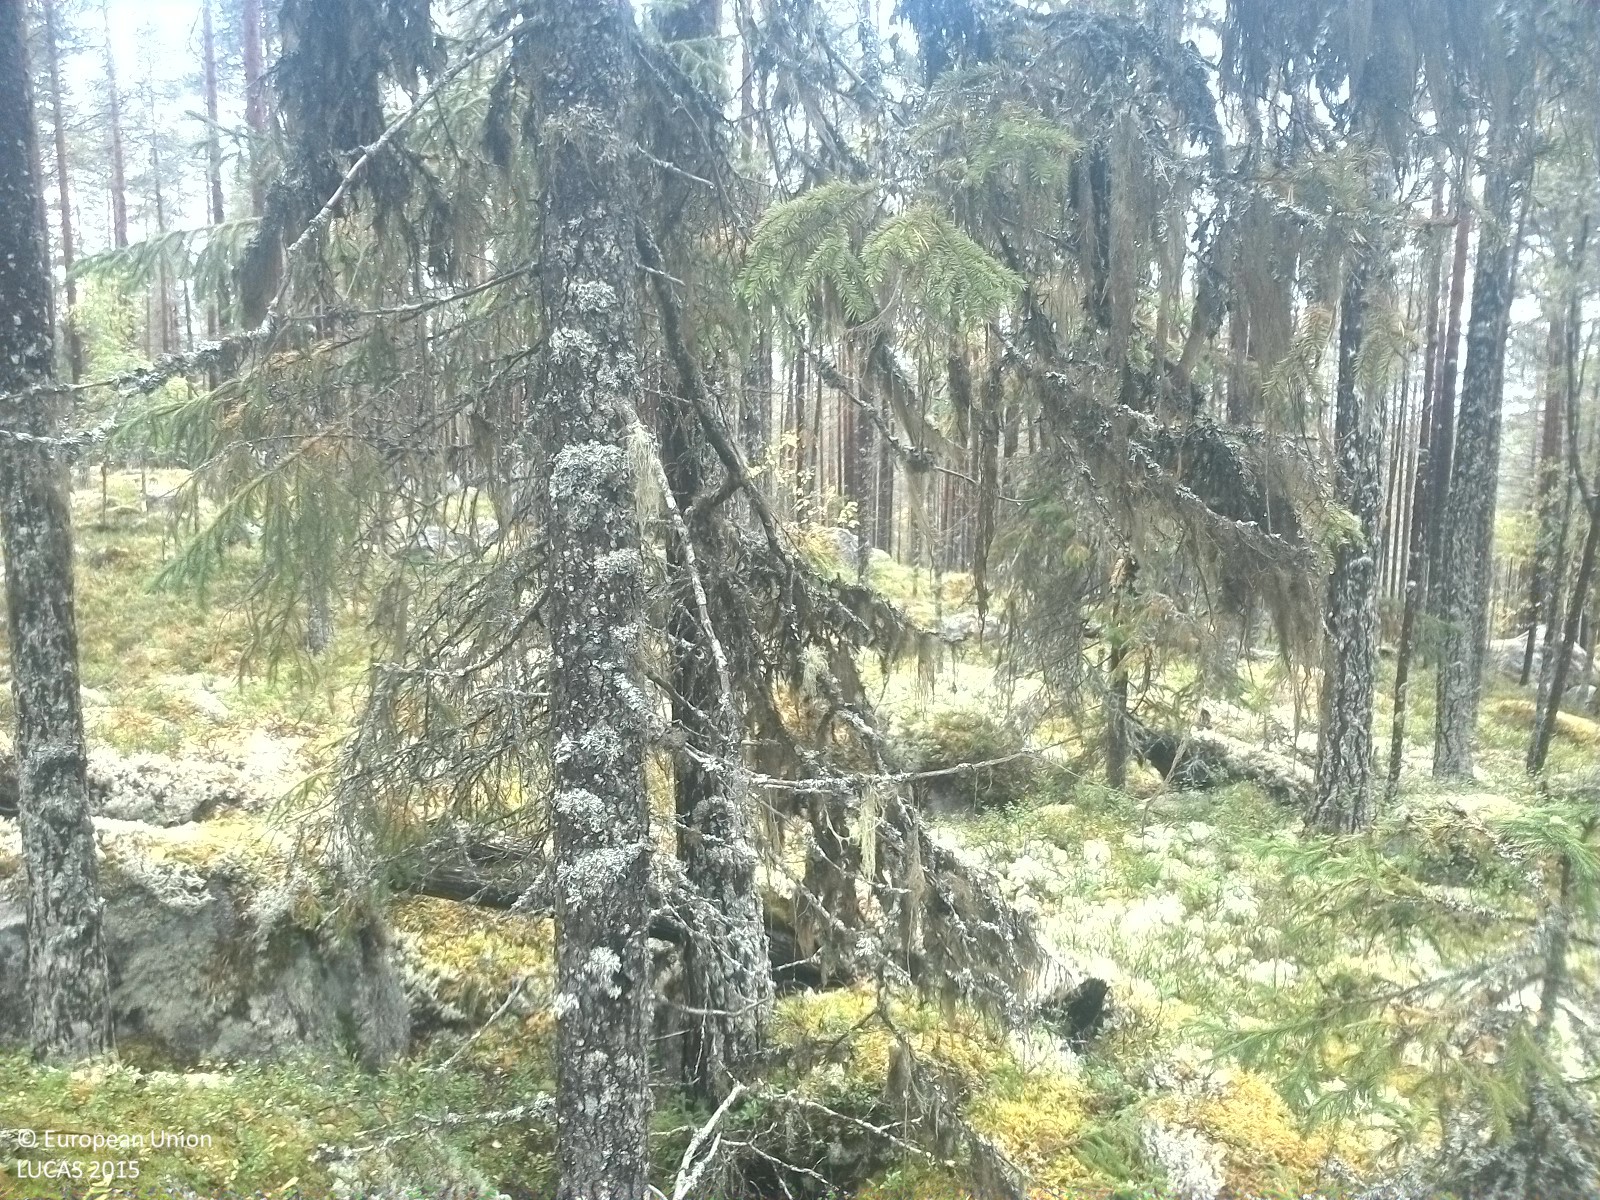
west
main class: Woodland
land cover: Pine dominated coniferous woodland
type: boreal forest
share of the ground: 25 - 50 %
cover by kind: coniferous forest trees 40 %, lichens and mosses 40 %, shrubs 20 %
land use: Forestry
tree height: > 5 m
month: September
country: SE
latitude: 62.2155
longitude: 15.6920
